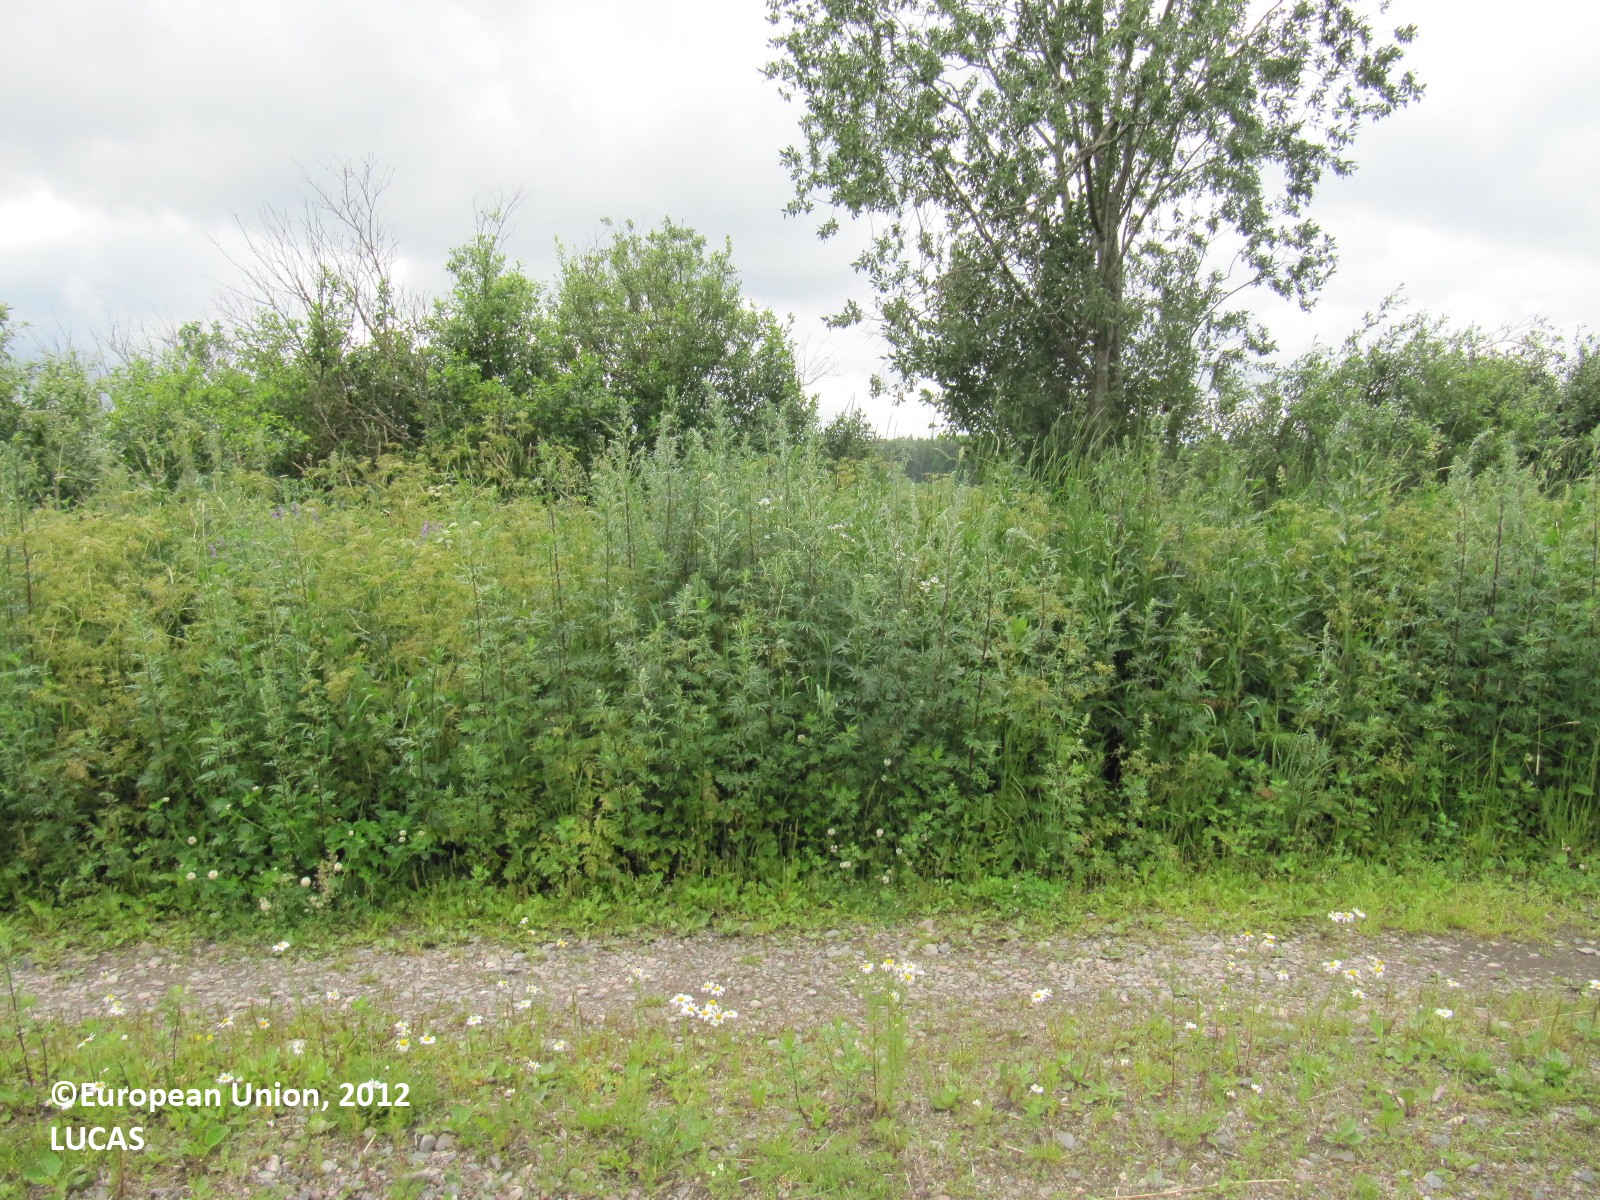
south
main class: Cropland
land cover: Barley
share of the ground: > 75 %
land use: Agriculture (excluding fallow land and kitchen gardens)
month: July
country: FI
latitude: 60.9192
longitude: 23.3047
